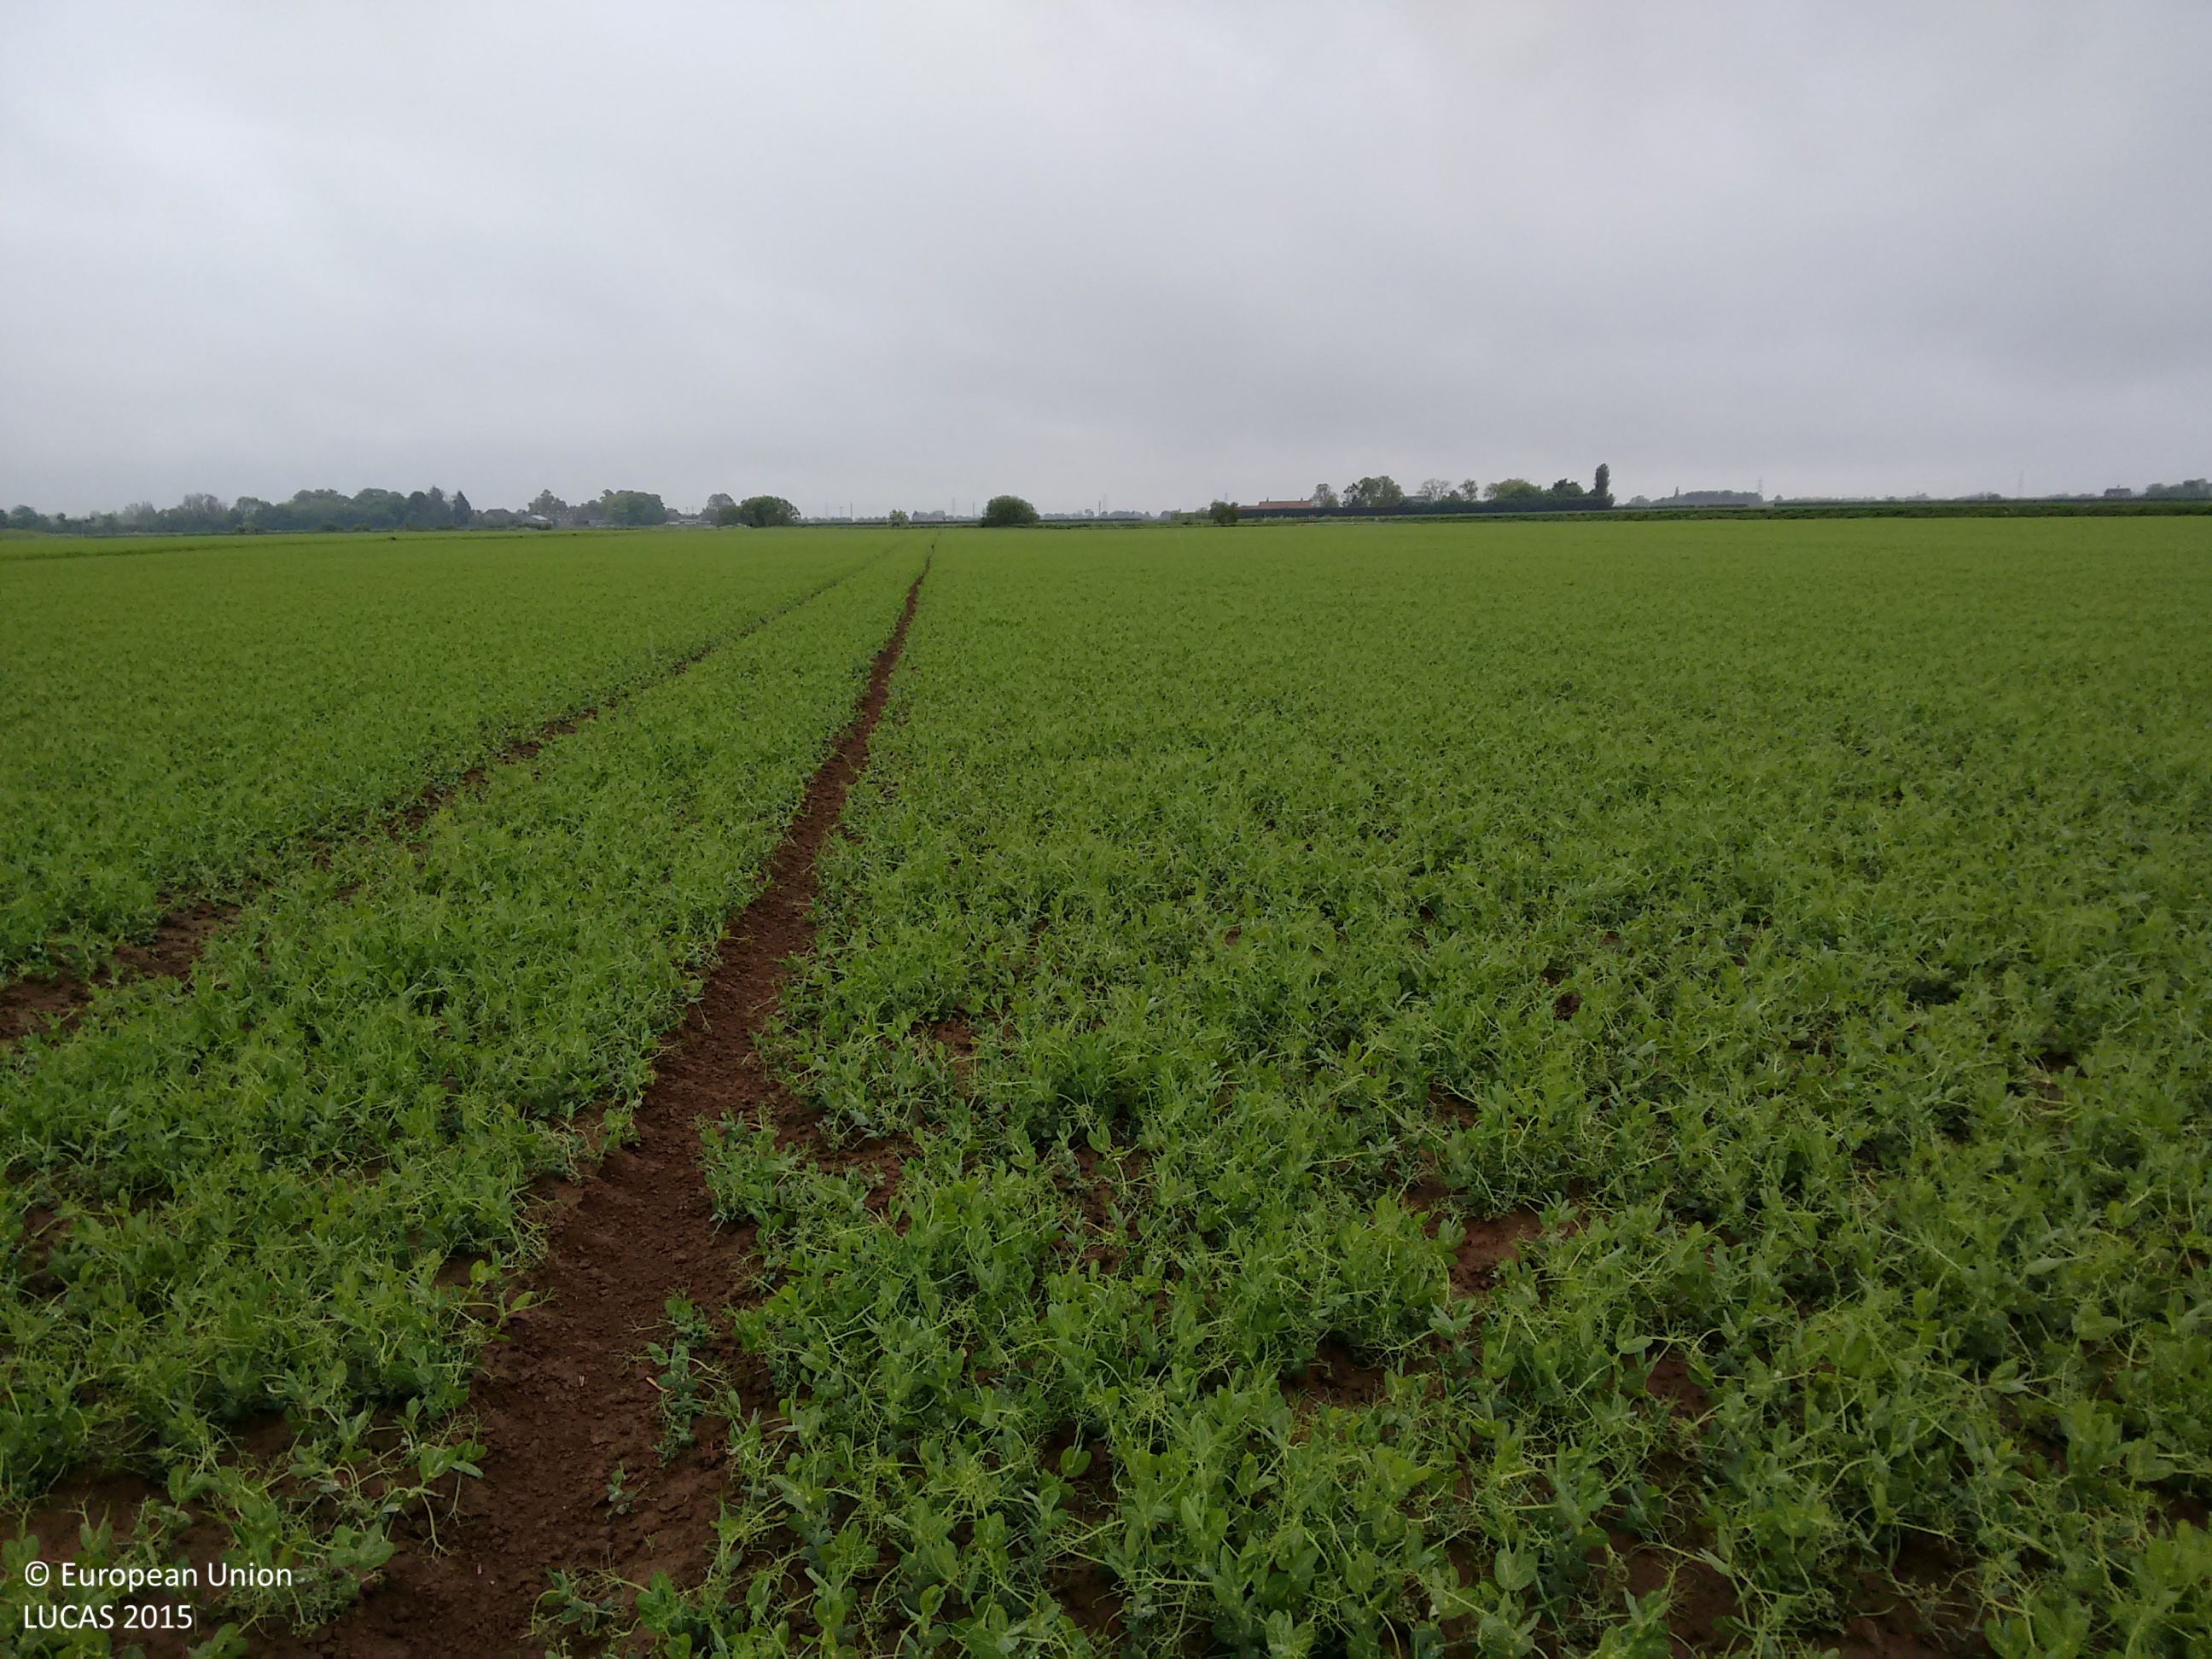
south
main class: Cropland
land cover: Dry pulses
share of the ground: 50 - 75 %
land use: Agriculture (excluding fallow land and kitchen gardens)
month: May
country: GB
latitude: 52.9215
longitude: -0.1328
